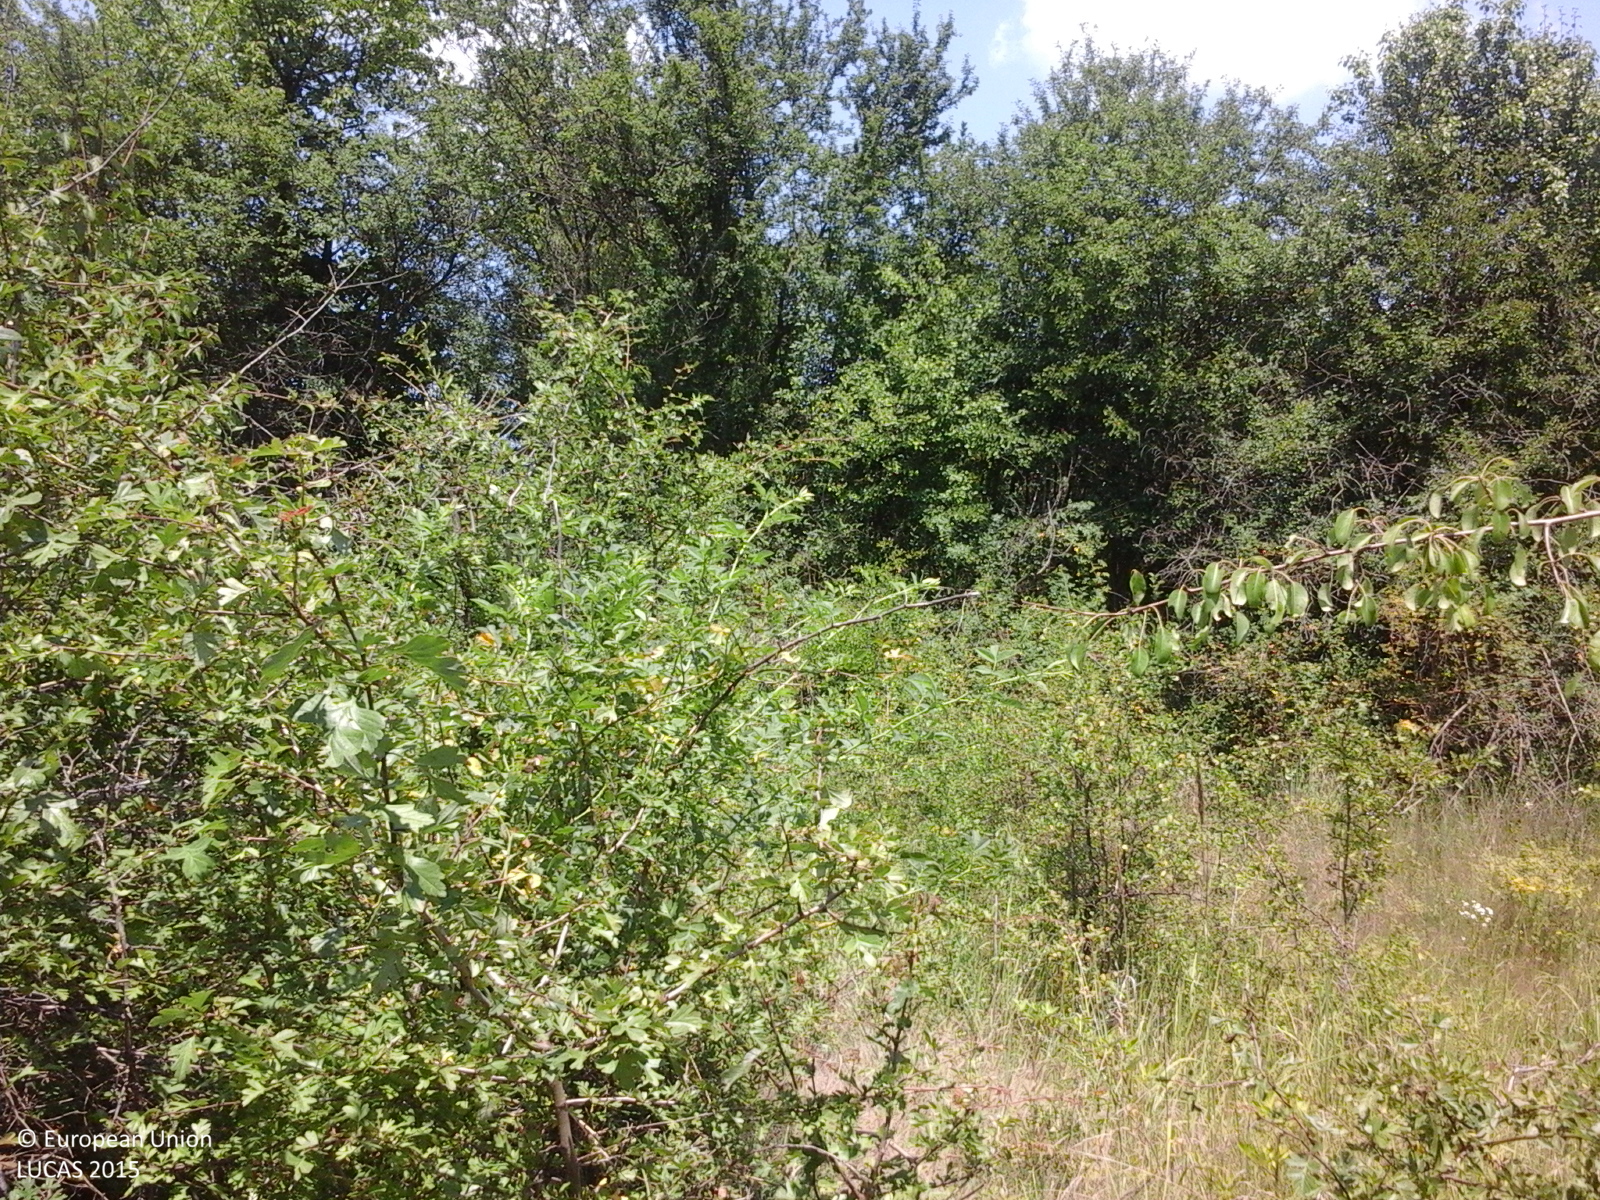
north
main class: Shrubland
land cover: Shrubland with sparse tree cover
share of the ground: > 75 %
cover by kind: shrubs 85 %, herbaceous plants 10 %, broadleaved forest trees 5 %
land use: Semi-natural and natural areas not in use
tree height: < 5 m
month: July
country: RO
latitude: 44.6737
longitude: 24.4136
